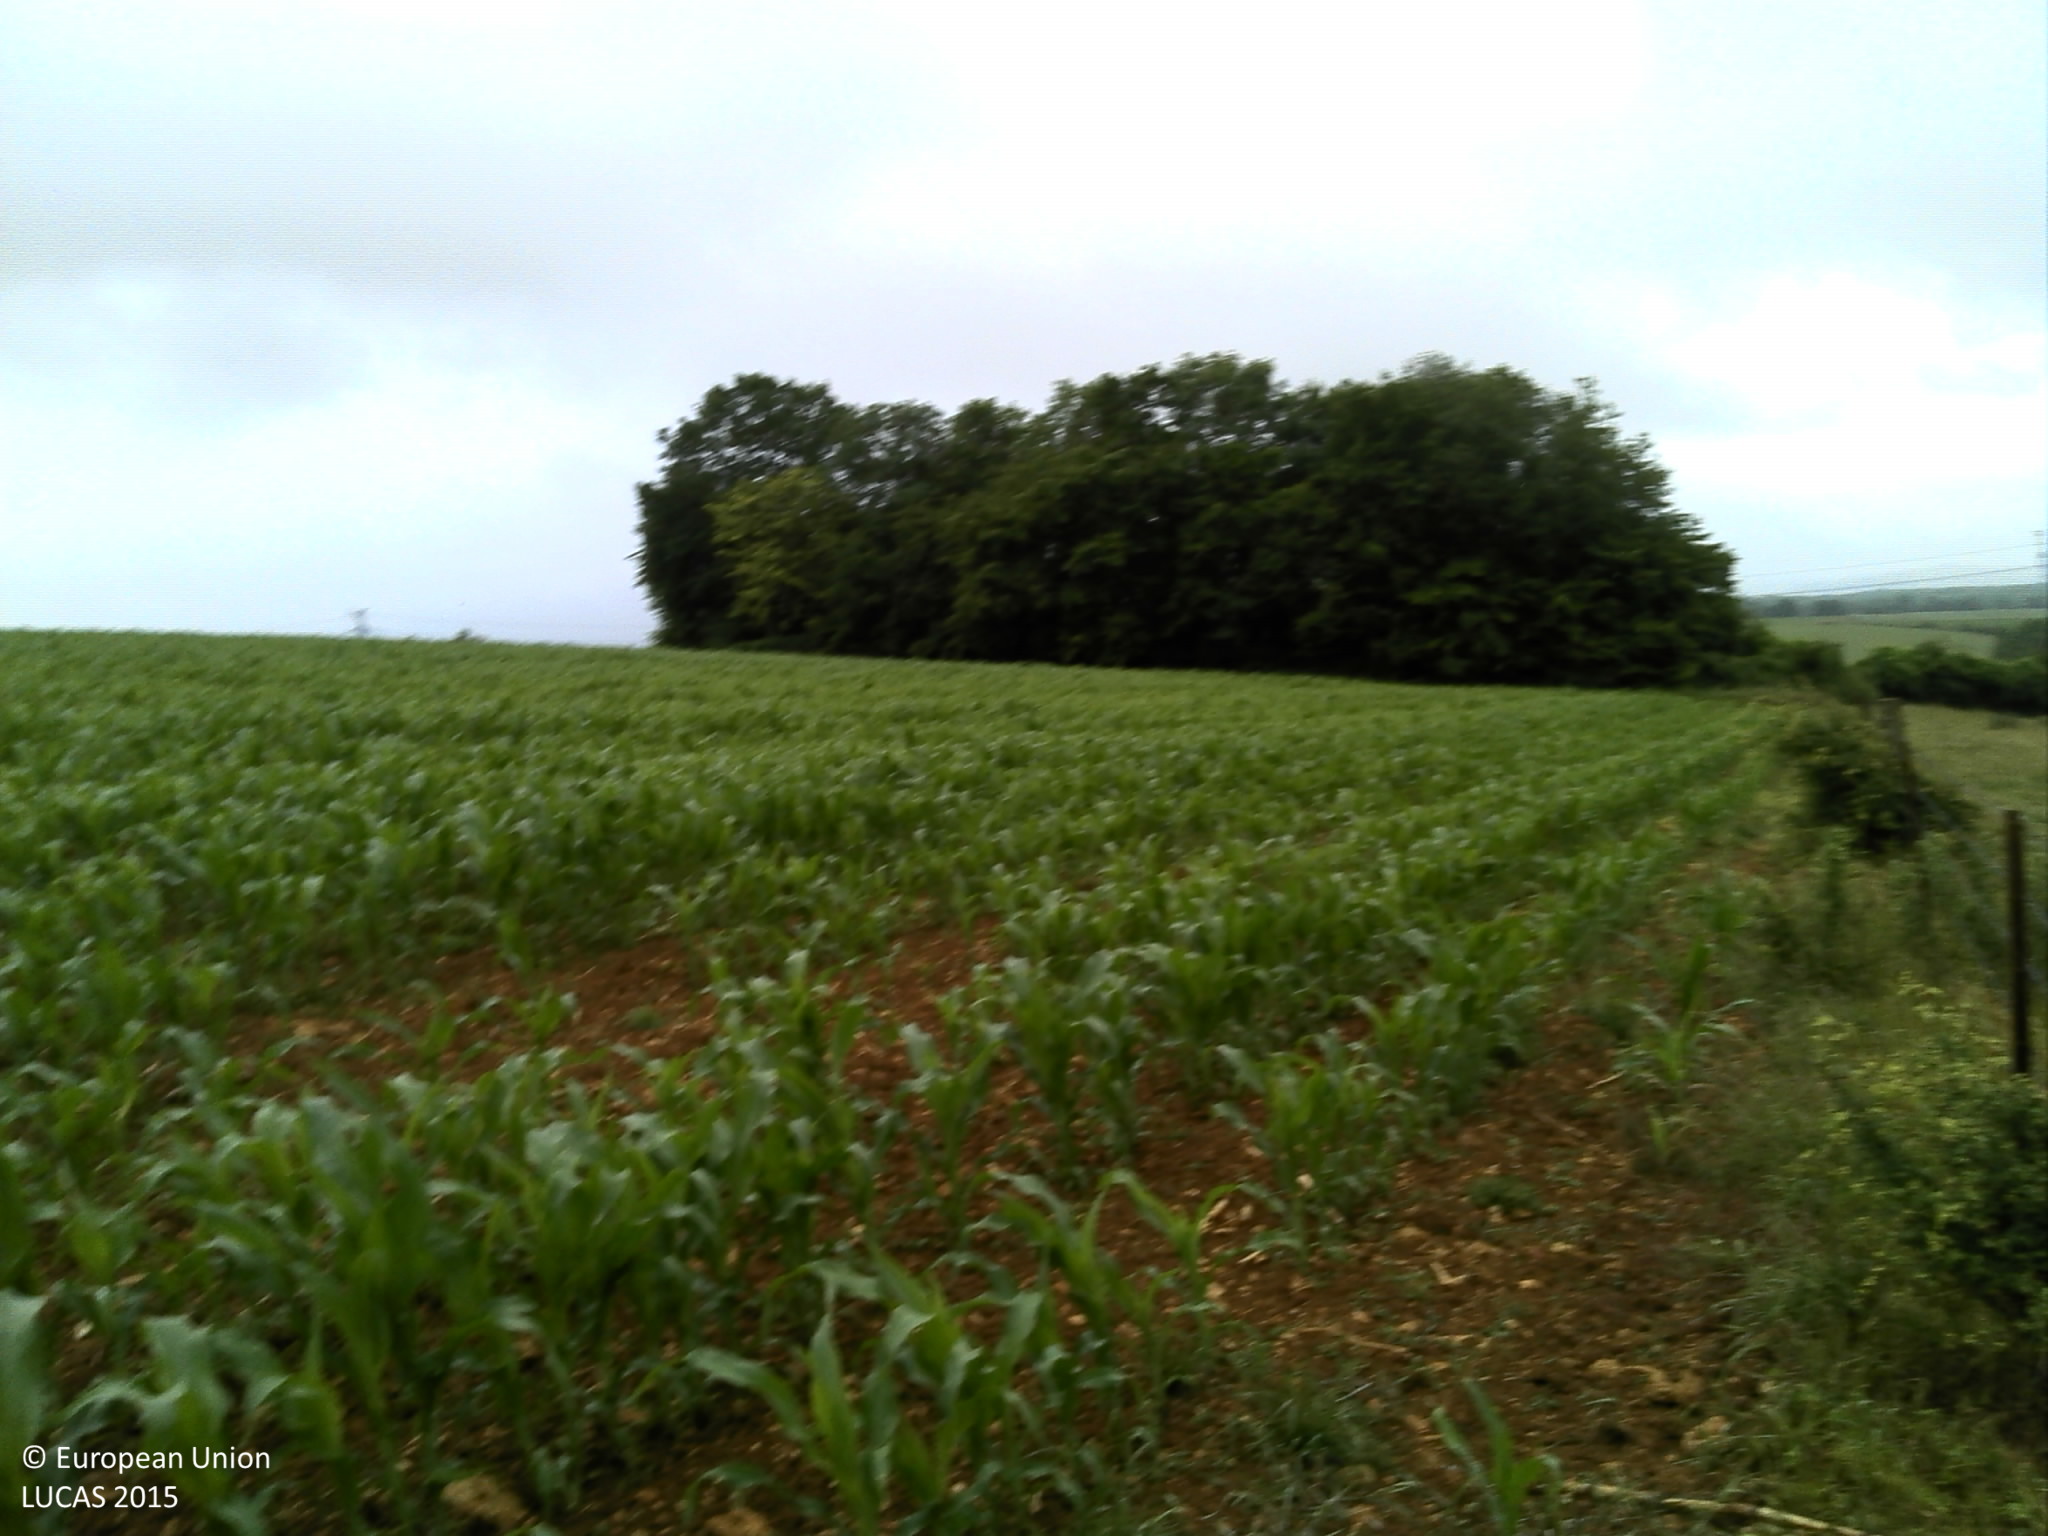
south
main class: Cropland
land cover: Maize
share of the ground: > 75 %
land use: Agriculture (excluding fallow land and kitchen gardens)
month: June
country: FR
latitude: 49.5369
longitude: 5.0645
